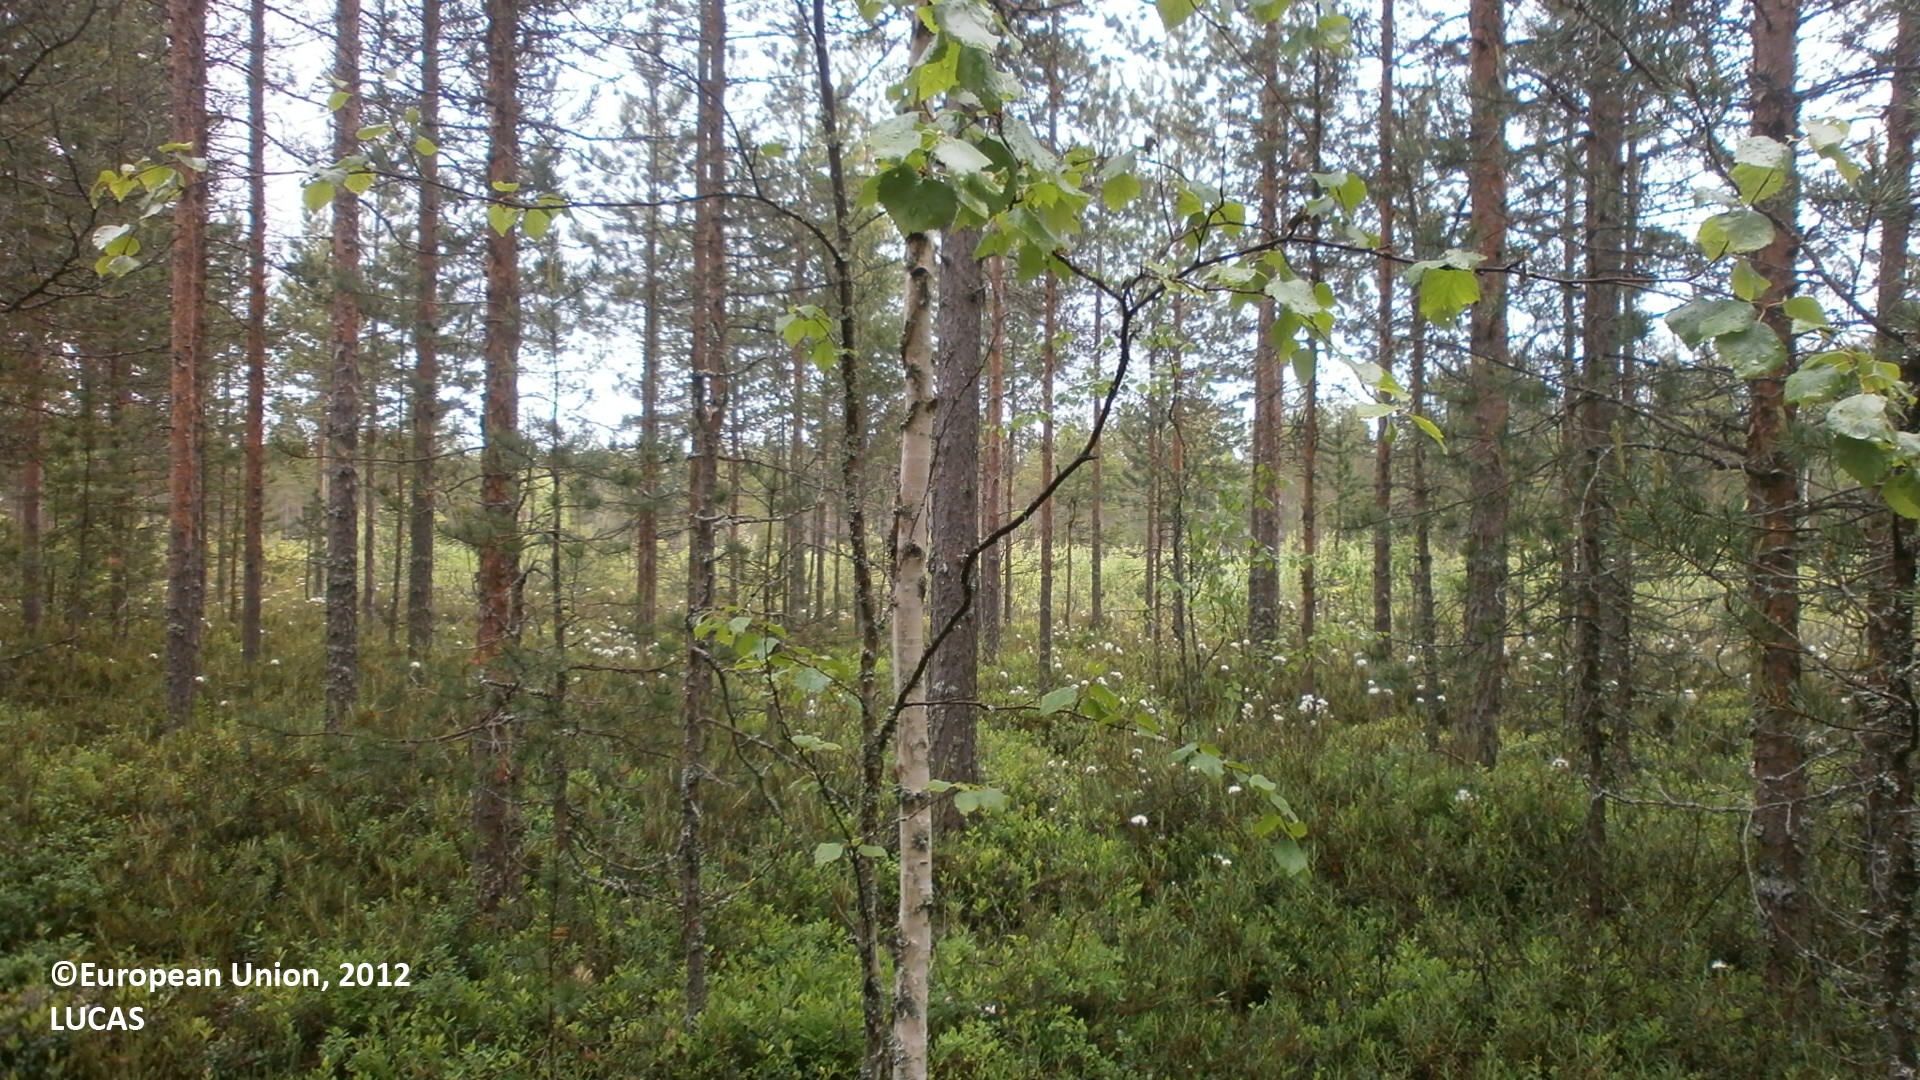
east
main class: Woodland
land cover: Pine dominated coniferous woodland
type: mire and swamp forests
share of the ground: > 75 %
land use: Forestry
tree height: > 5 m
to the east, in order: Pine dominated coniferous woodland; Ditches and canals; Pine dominated coniferous woodland; Pine dominated mixed woodland; Ditches and canals; Electric lines; Pine dominated mixed woodland; Tracks; Electric lines; Pine dominated mixed woodland; Pine dominated coniferous woodland; Ditches and canals; Pine dominated coniferous woodland
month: June
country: FI
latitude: 64.7782
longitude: 25.2884
